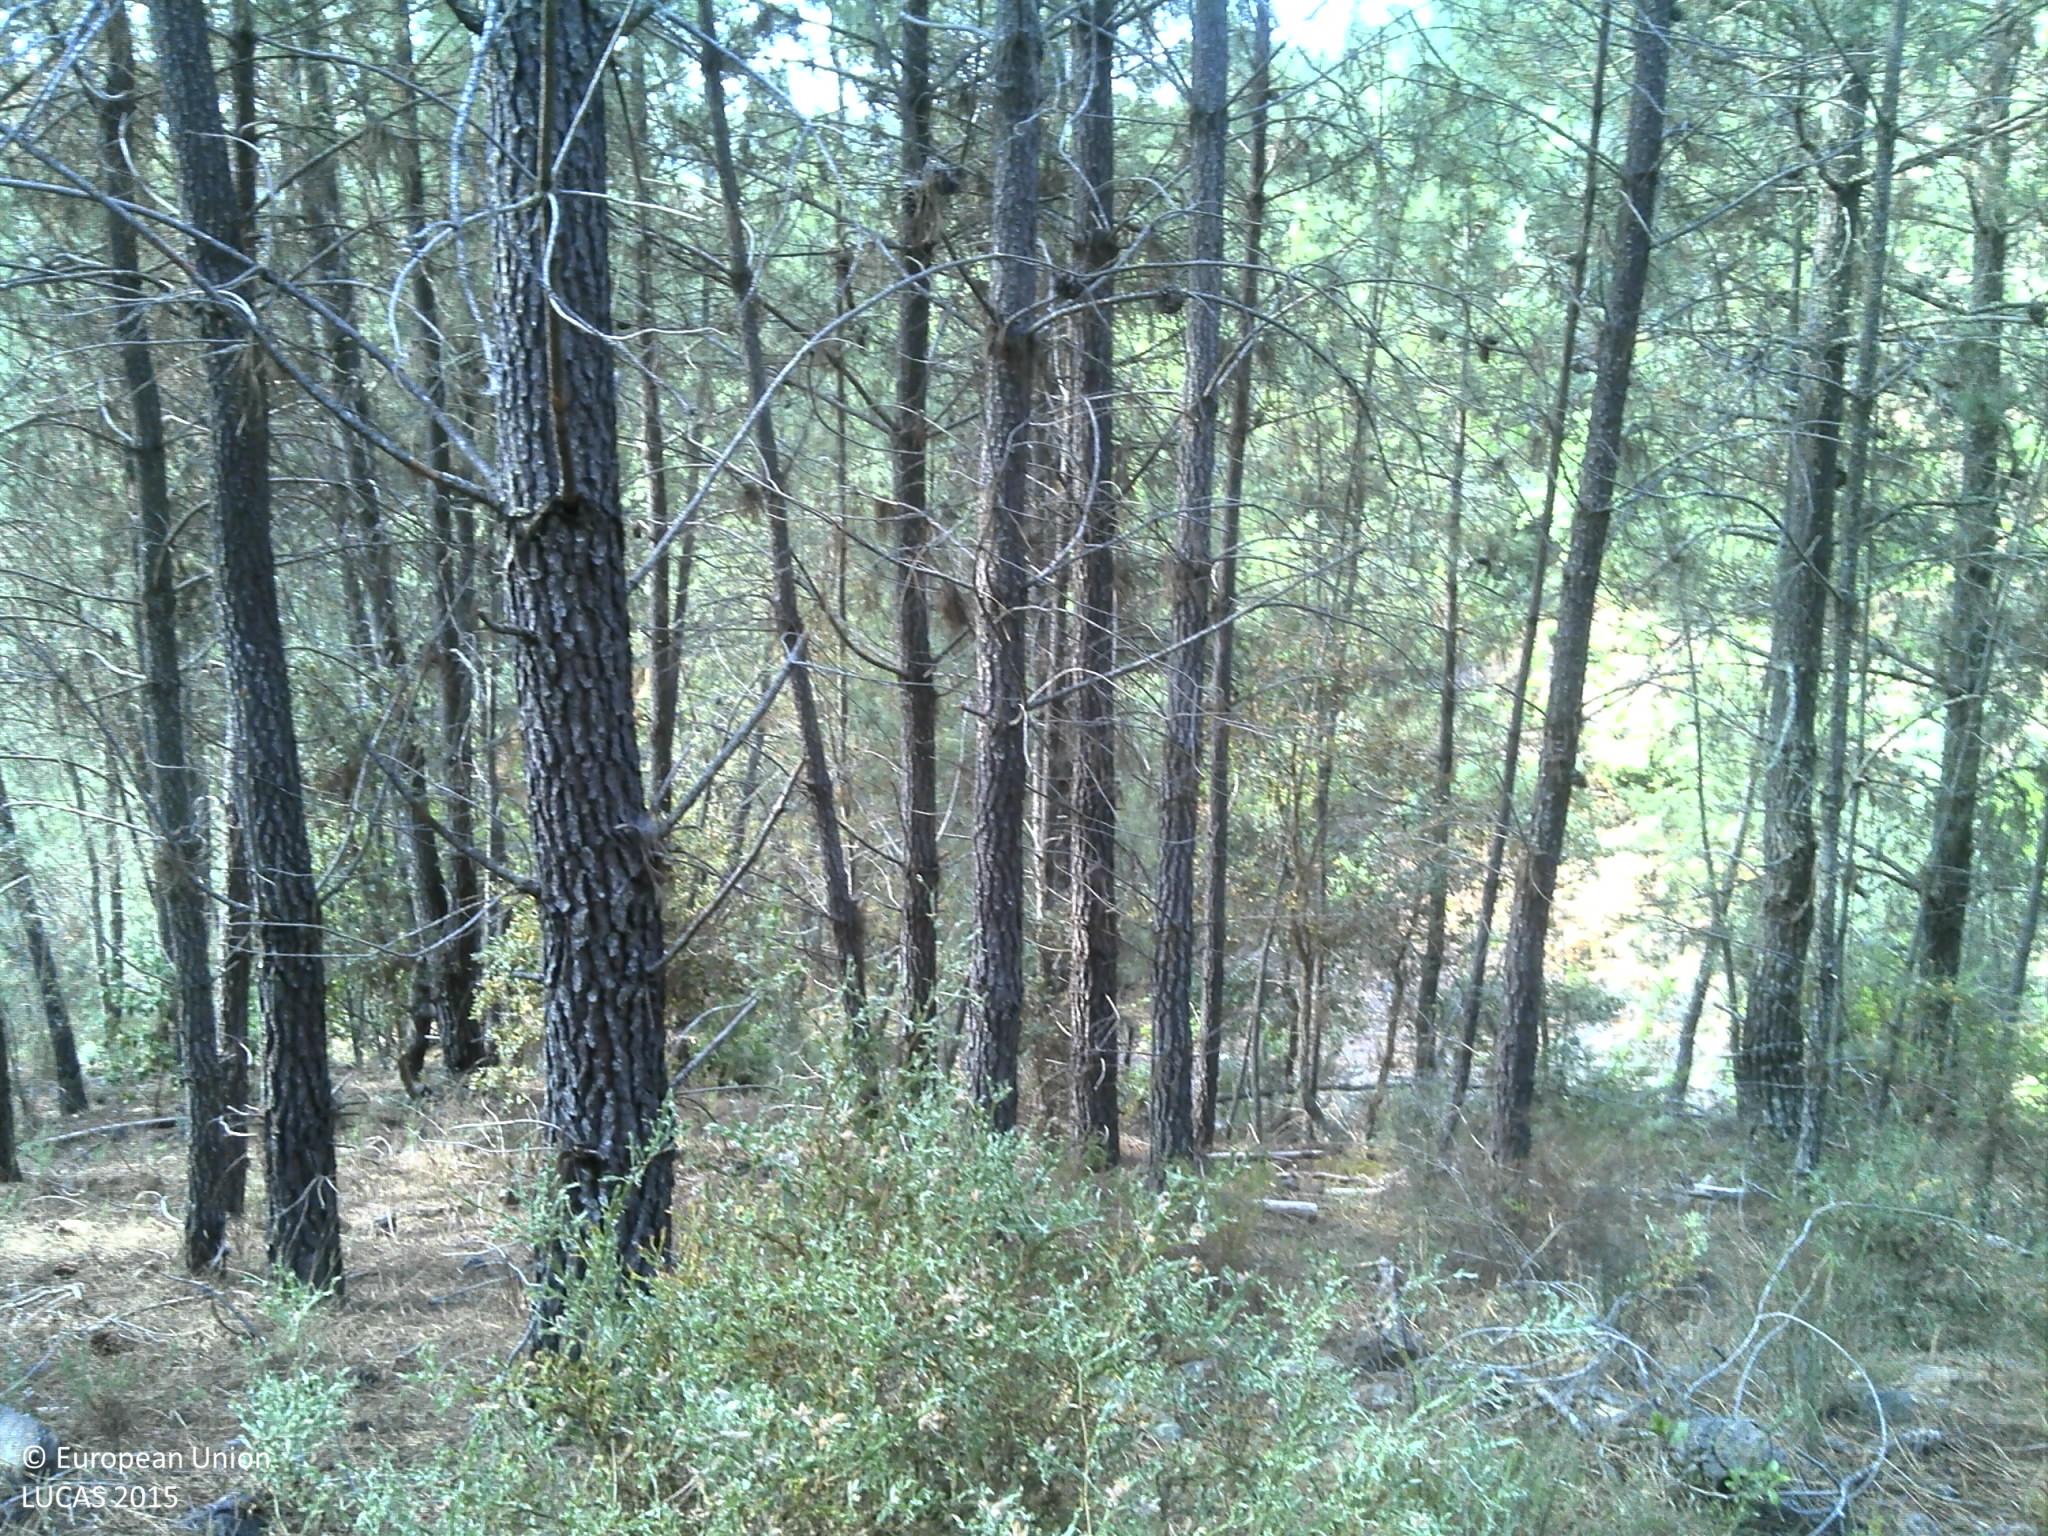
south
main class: Woodland
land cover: Pine dominated coniferous woodland
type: coniferous forest of the mediterranean region
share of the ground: 50 - 75 %
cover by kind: coniferous forest trees 60 %, unconsolidated bare surface 25 %, shrubs 15 %
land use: Forestry
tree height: > 5 m
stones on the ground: 10 - 25 %
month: June
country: PT
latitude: 41.2614
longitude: -7.5143
